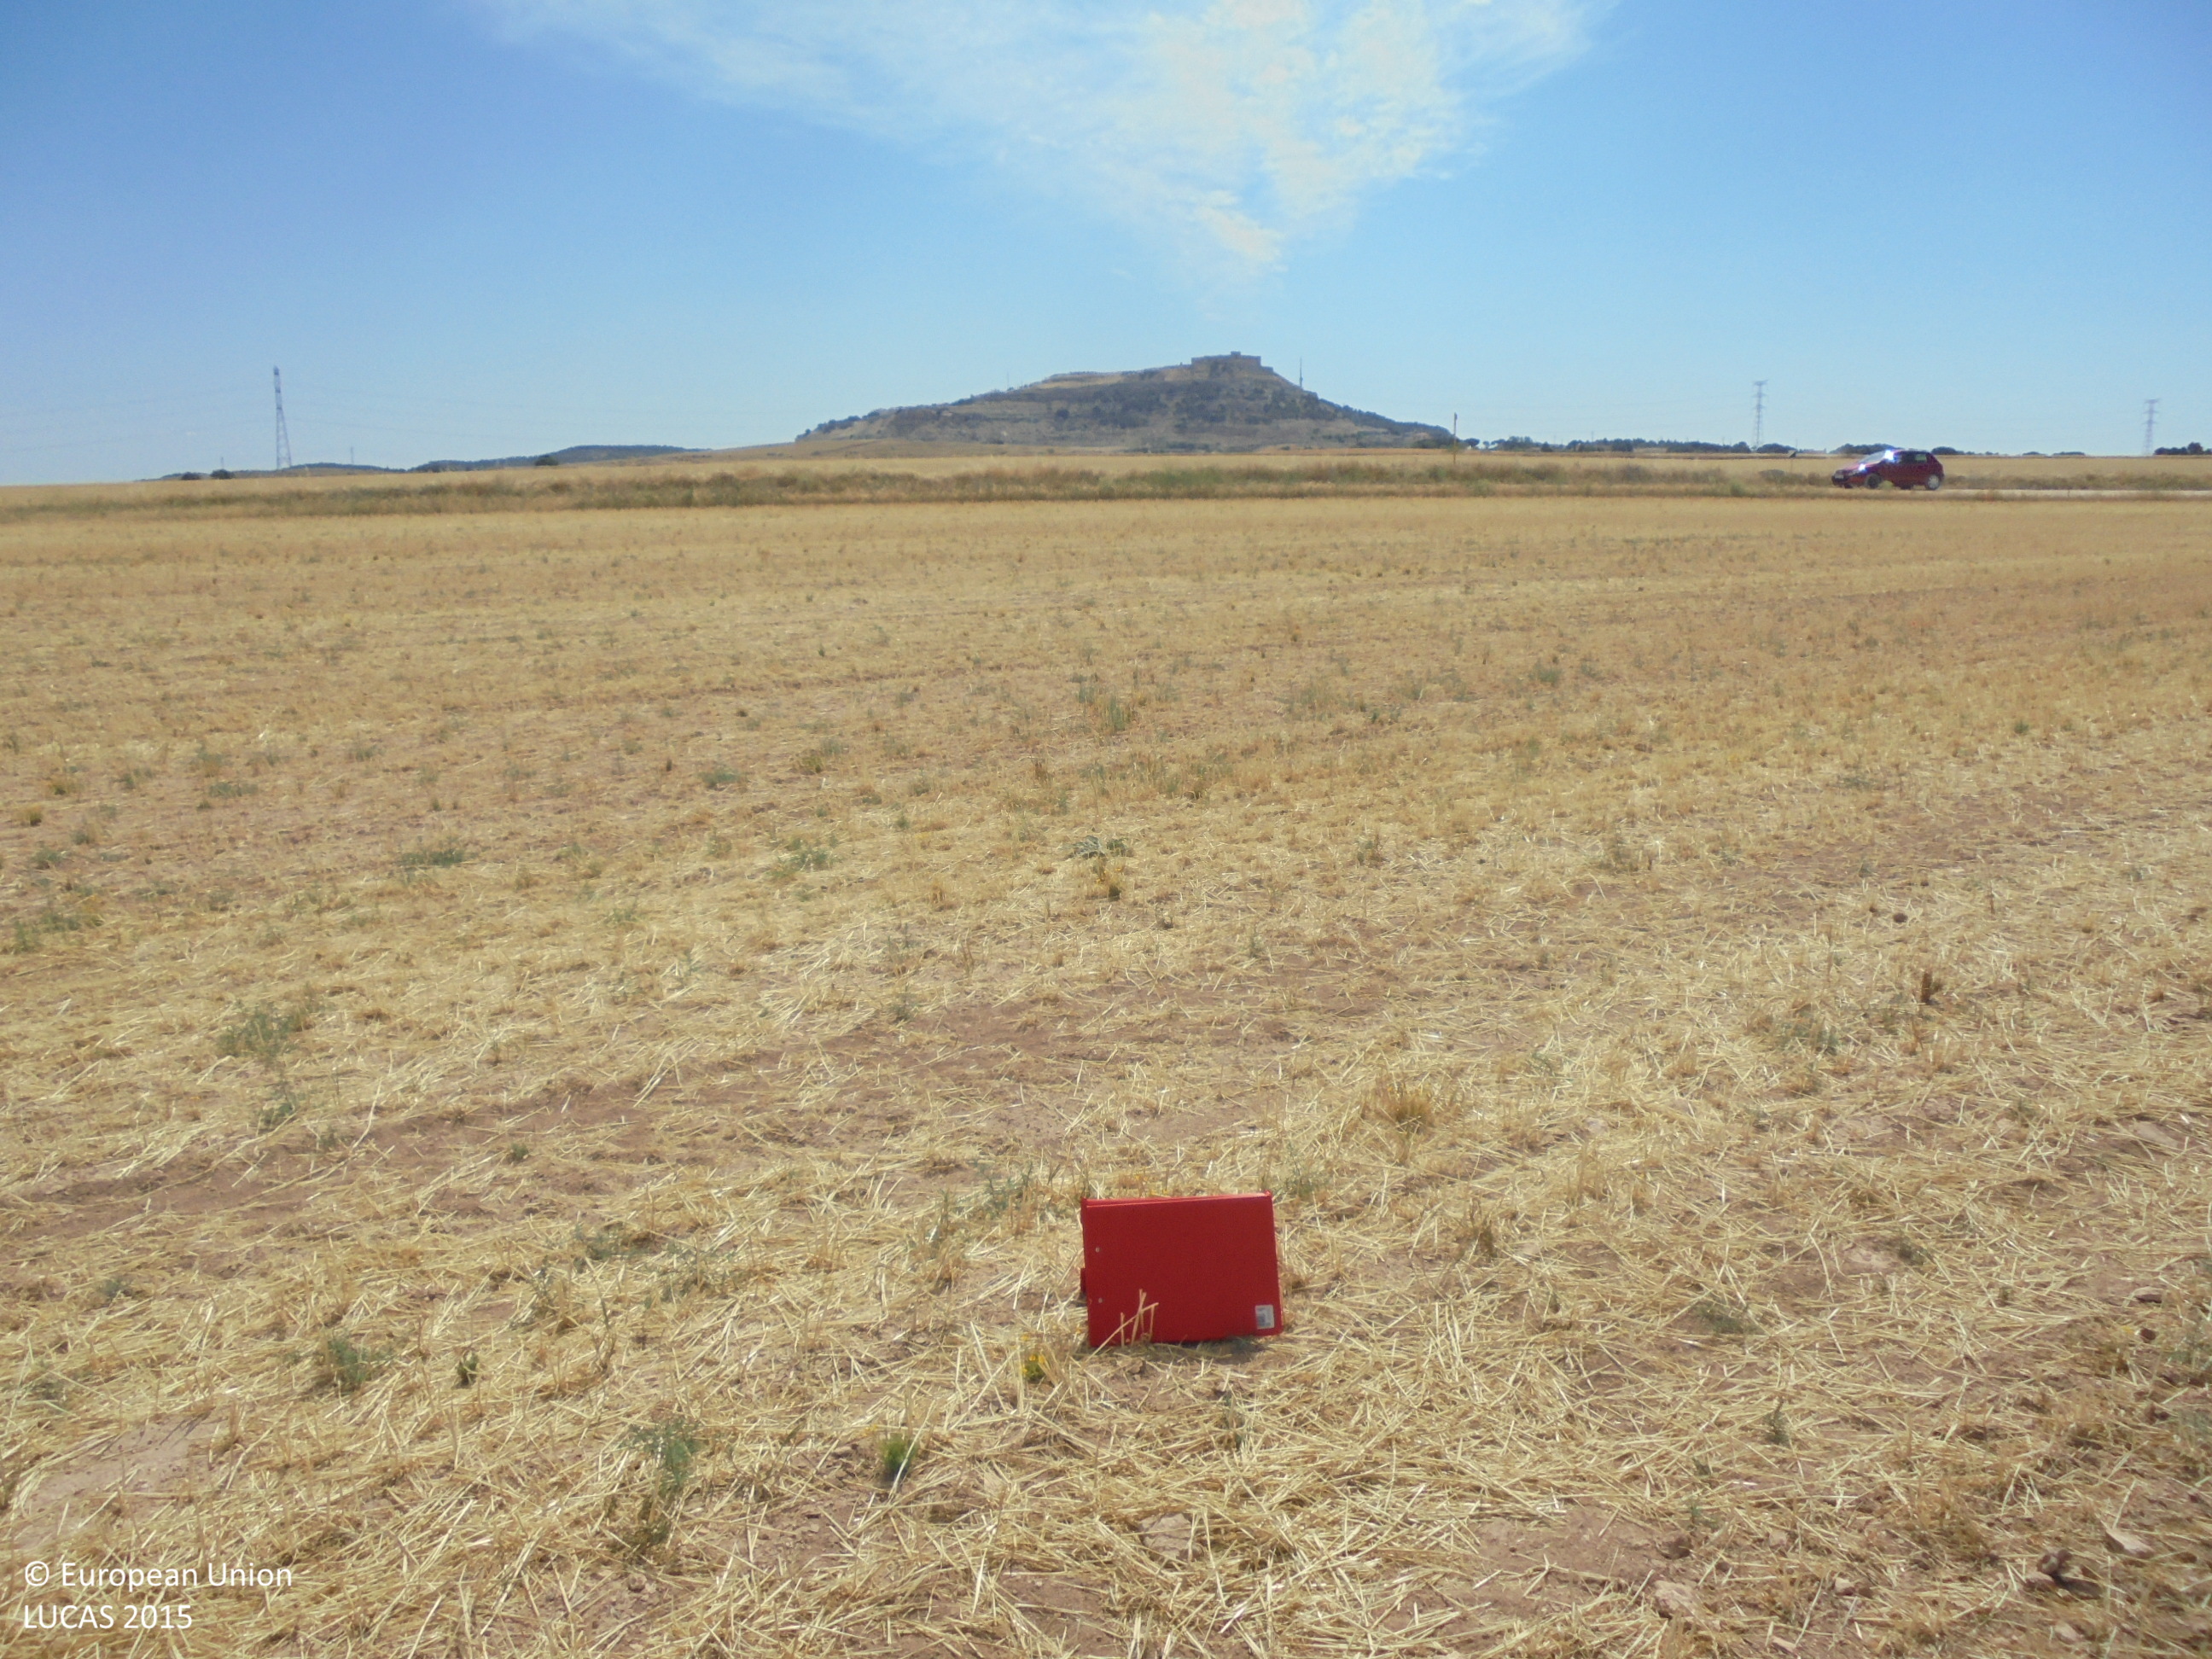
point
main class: Cropland
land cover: Barley
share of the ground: < 10 %
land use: Agriculture (excluding fallow land and kitchen gardens)
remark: Harvested field
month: June
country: ES
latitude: 38.9189
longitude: -1.7514
